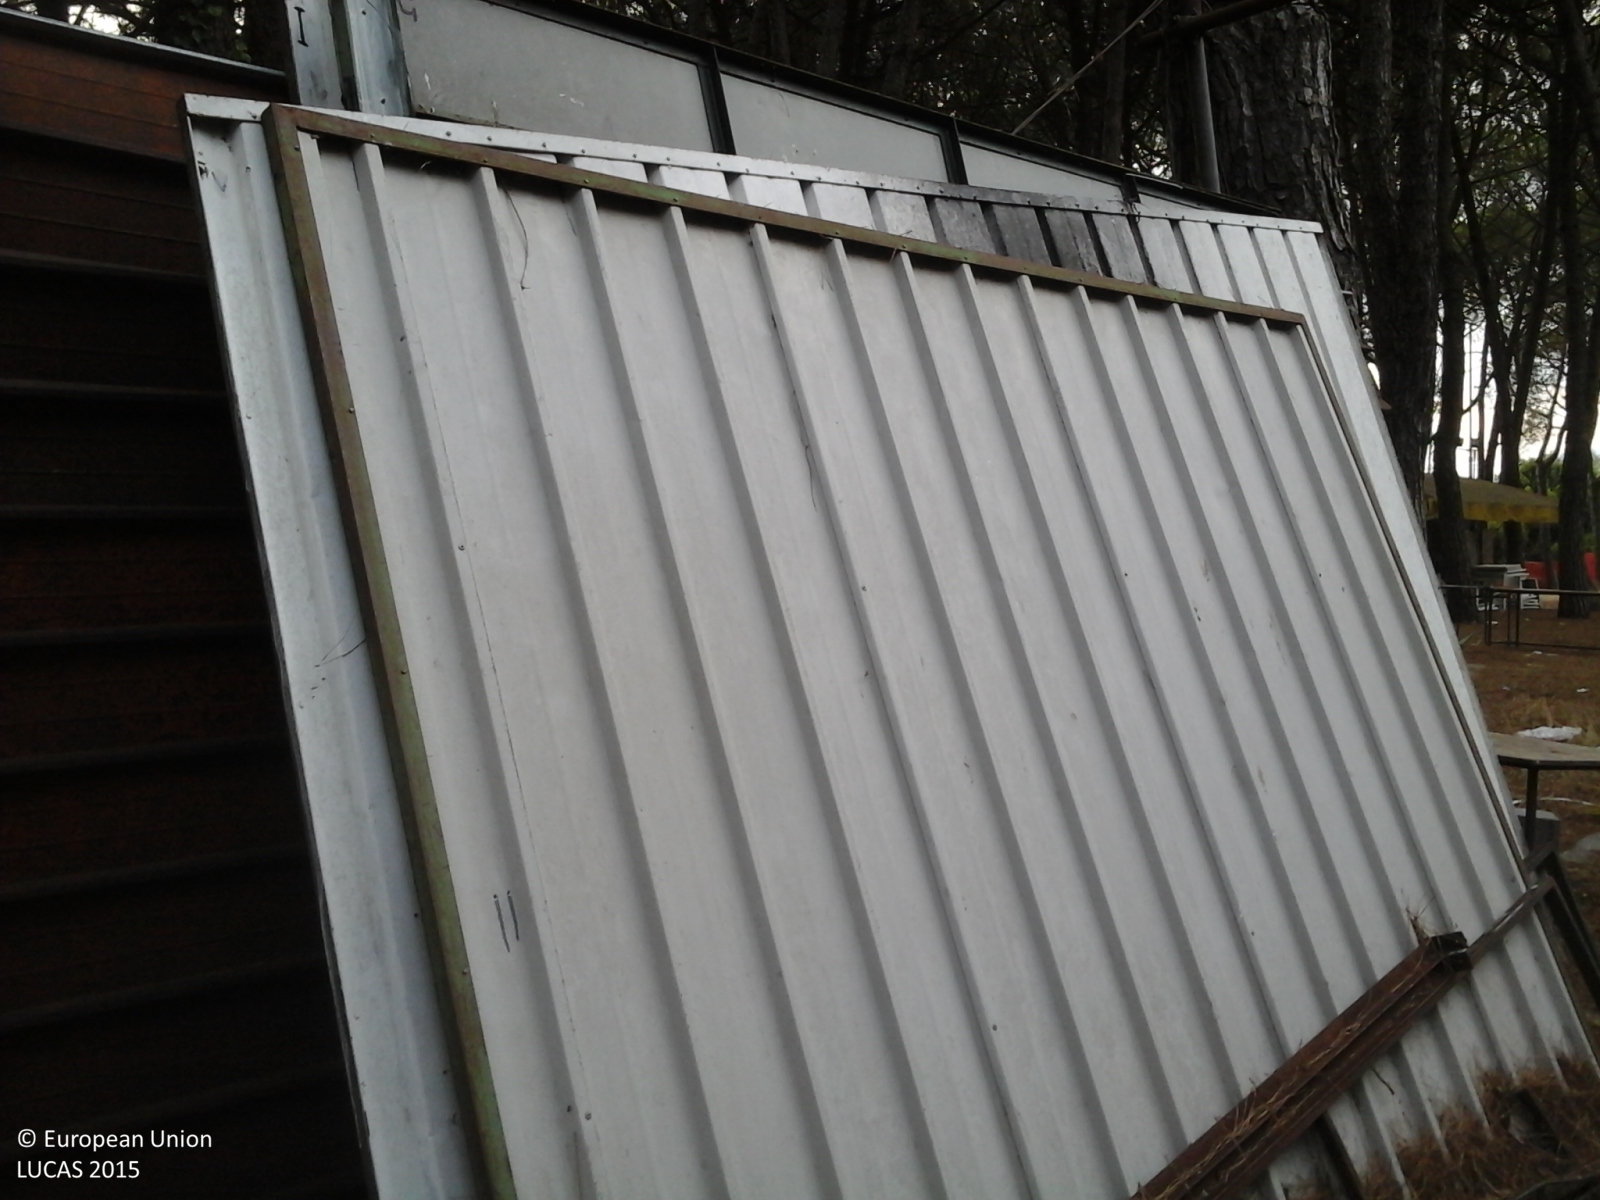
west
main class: Grassland
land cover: Grassland with sparse tree/shrub cover
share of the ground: > 75 %
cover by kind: herbaceous plants 95 %, coniferous forest trees 5 %
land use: Residential
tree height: > 5 m
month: August
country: IT
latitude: 43.8791
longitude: 10.7076
